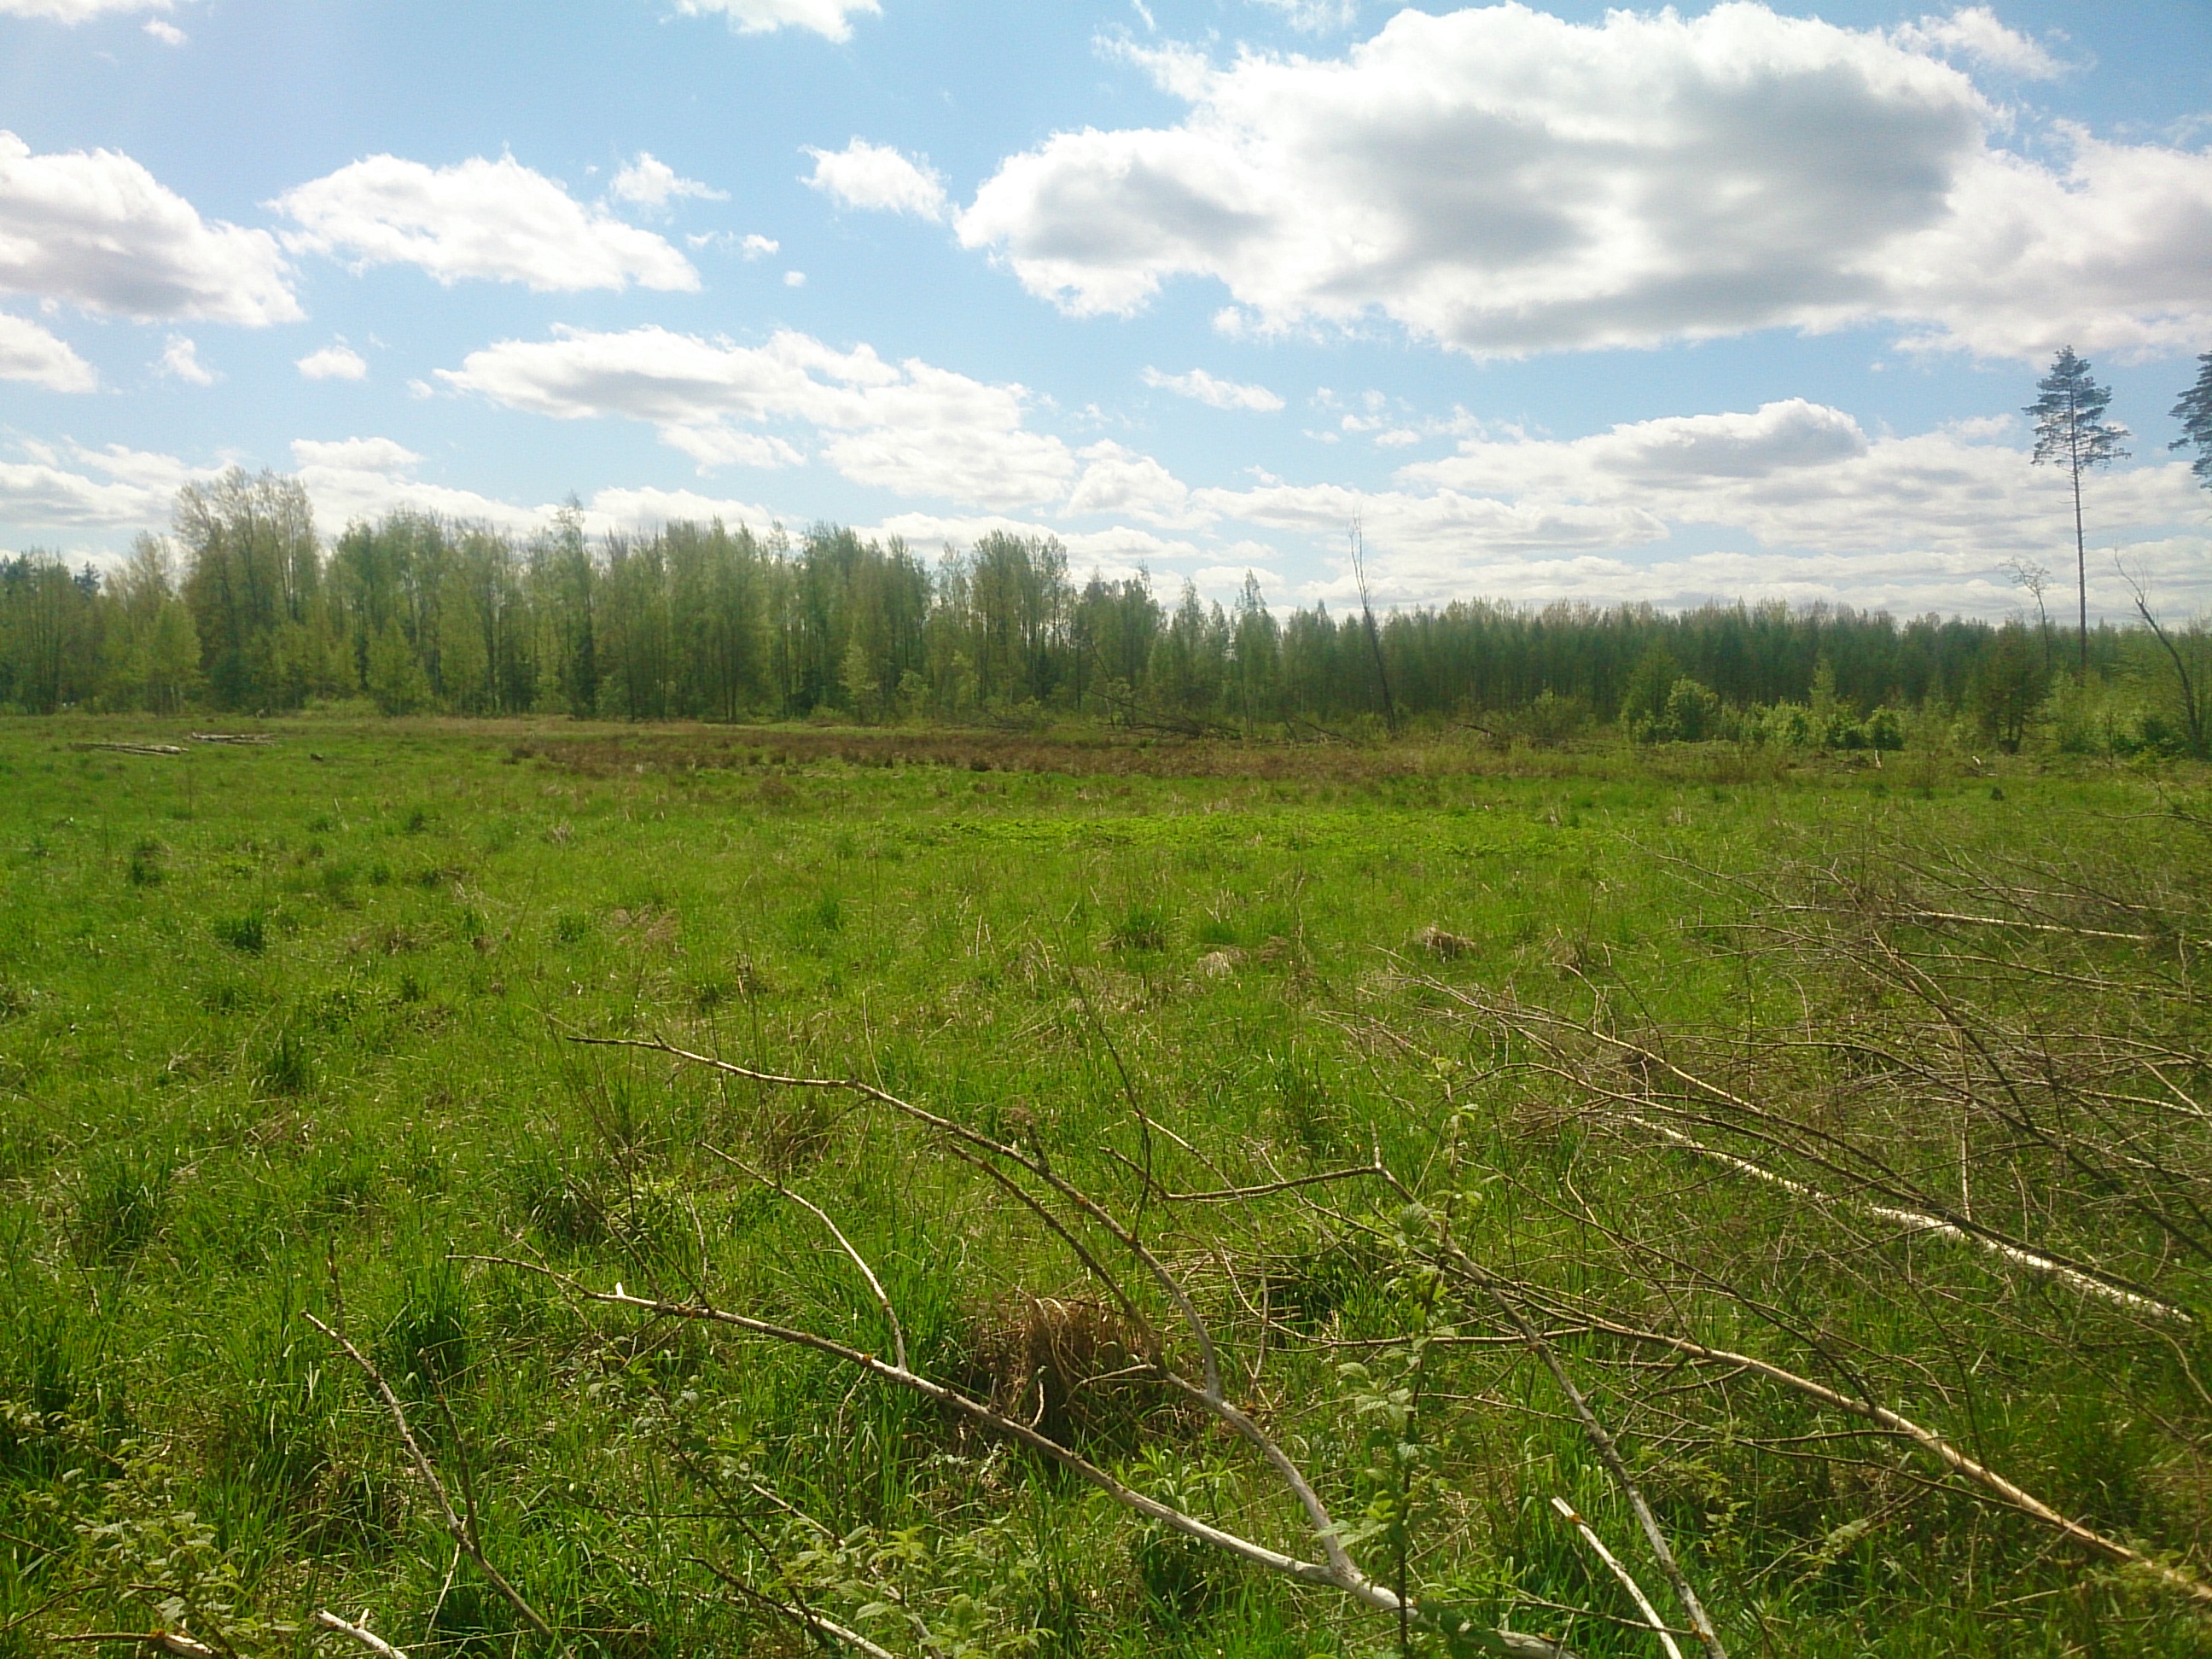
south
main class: Shrubland
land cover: Shrubland without tree cover
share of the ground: > 75 %
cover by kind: shrubs 90 %, herbaceous plants 10 %
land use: Abandoned areas
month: May
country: LV
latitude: 56.7603
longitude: 24.0712
